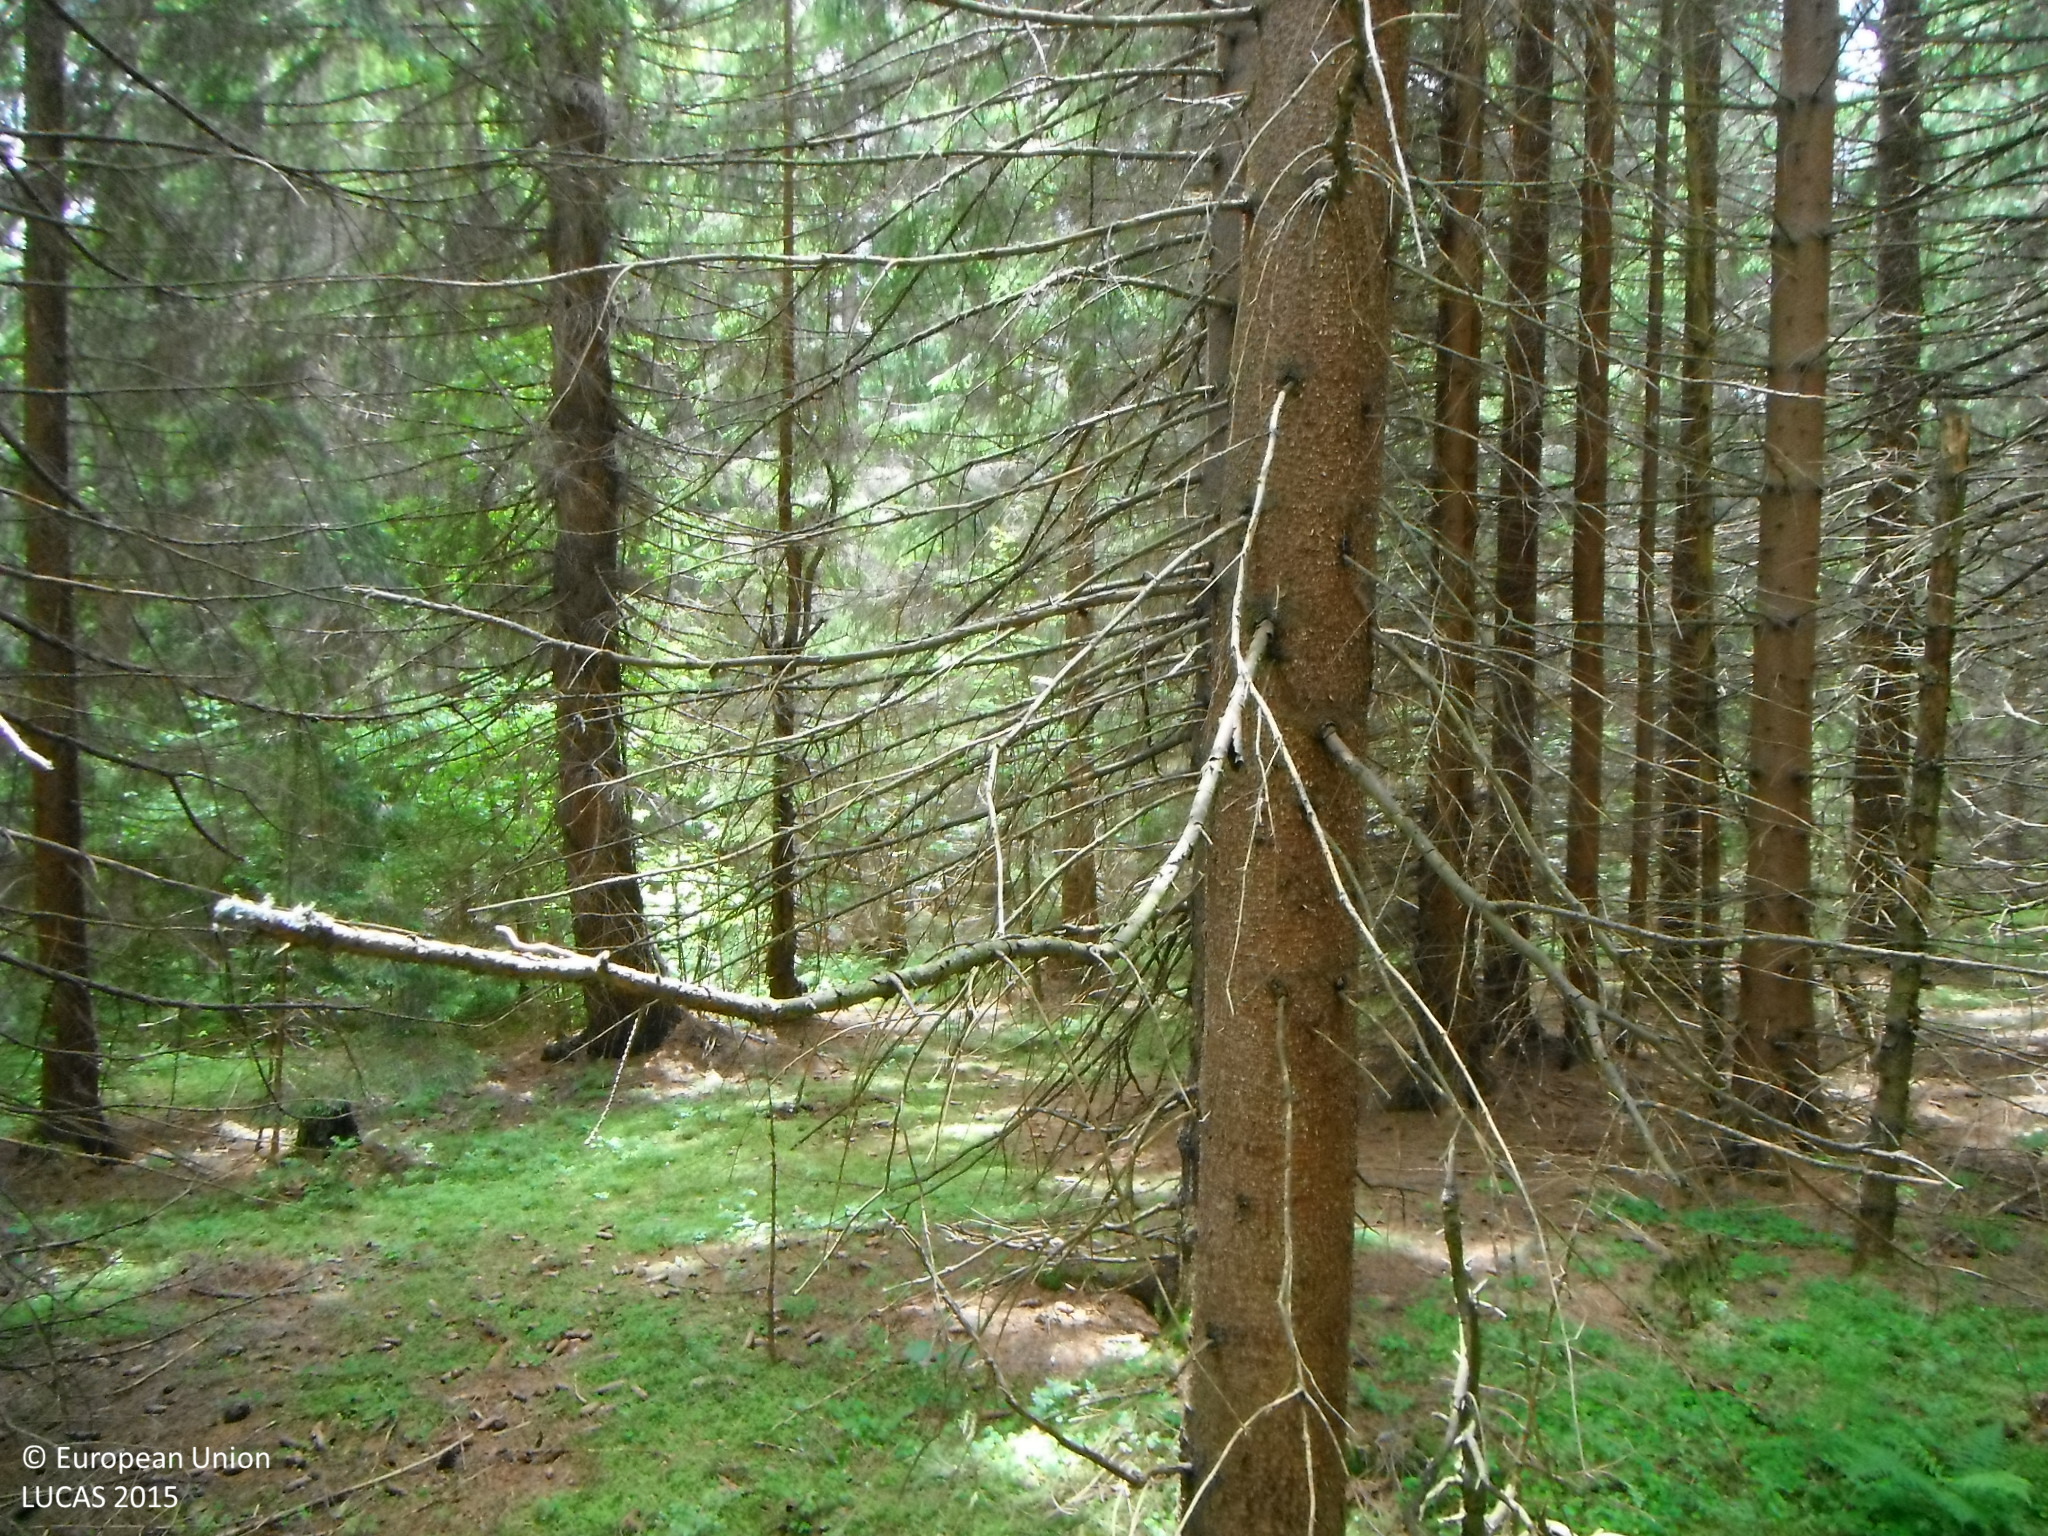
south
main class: Woodland
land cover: Spruce dominated coniferous woodland
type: alpine coniferous forest
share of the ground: > 75 %
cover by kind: coniferous forest trees 100 %
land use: Forestry
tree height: > 5 m
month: June
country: SK
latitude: 49.1908
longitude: 19.4801
